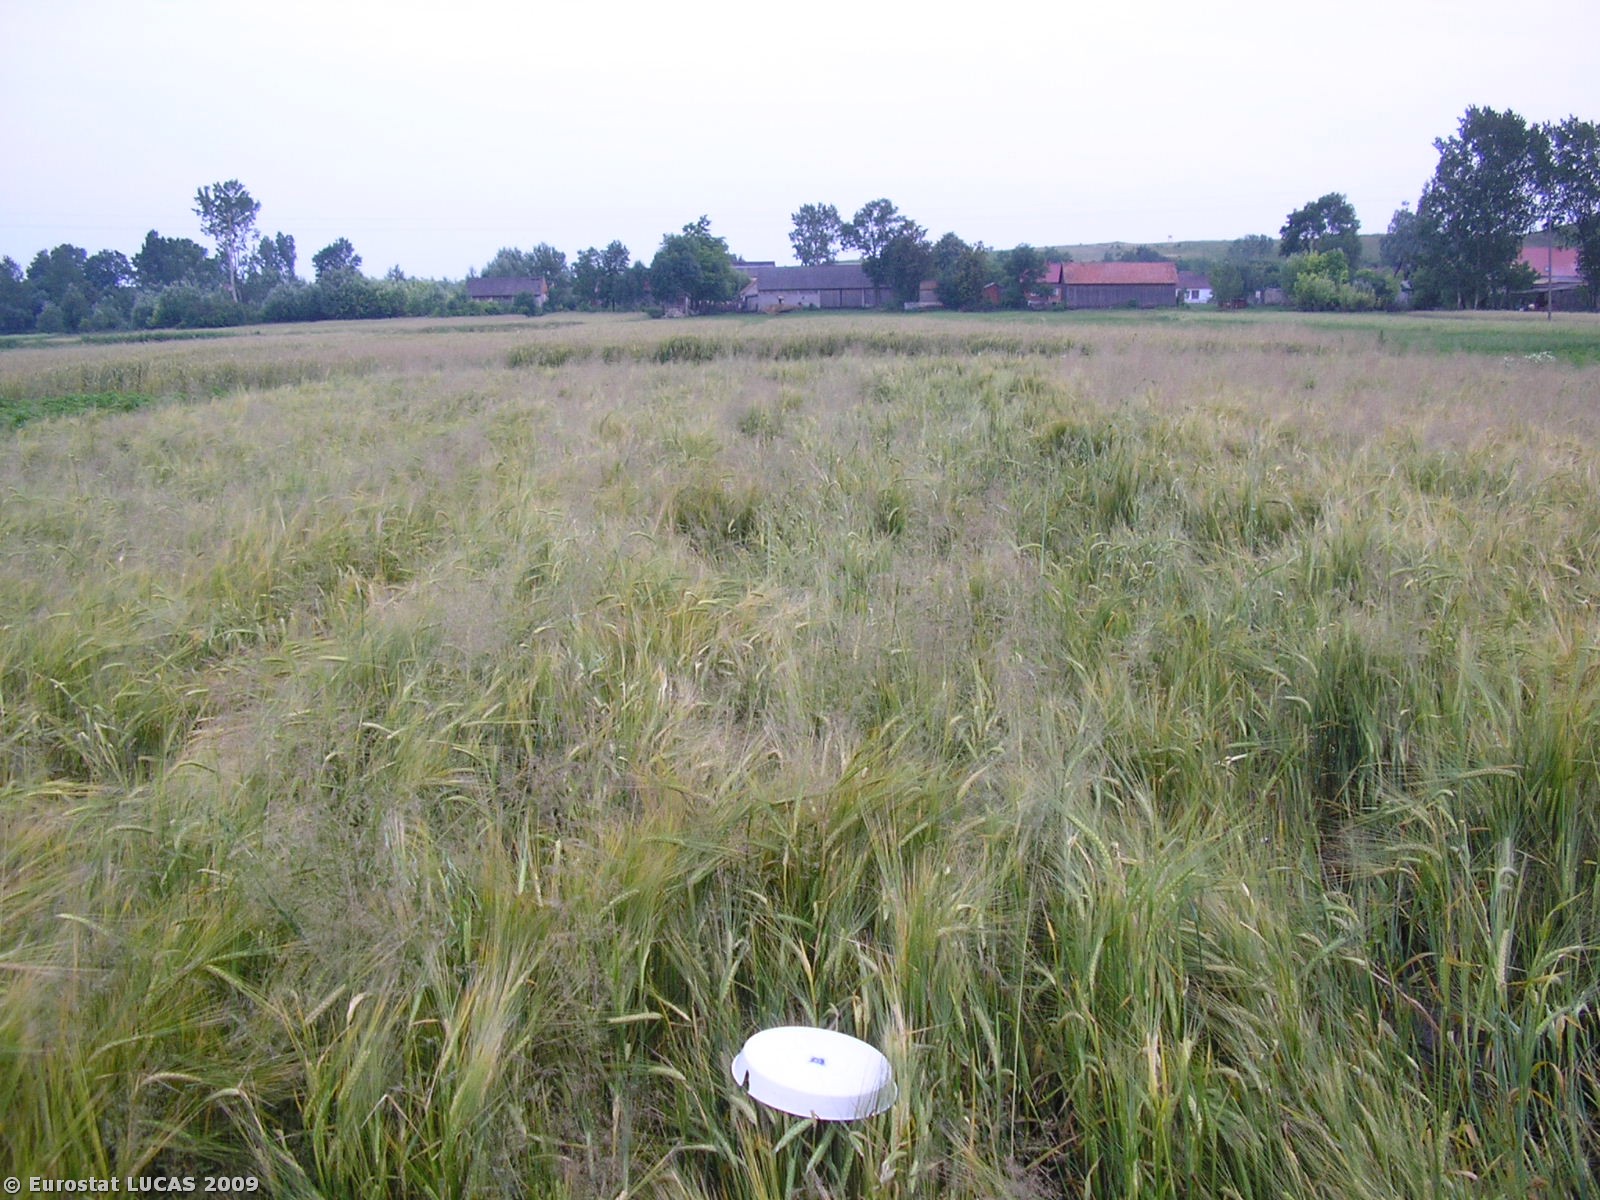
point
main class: Cropland
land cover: Barley
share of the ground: > 75 %
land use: Agriculture (excluding fallow land and kitchen gardens)
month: June
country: PL
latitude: 50.4286
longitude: 20.6396
